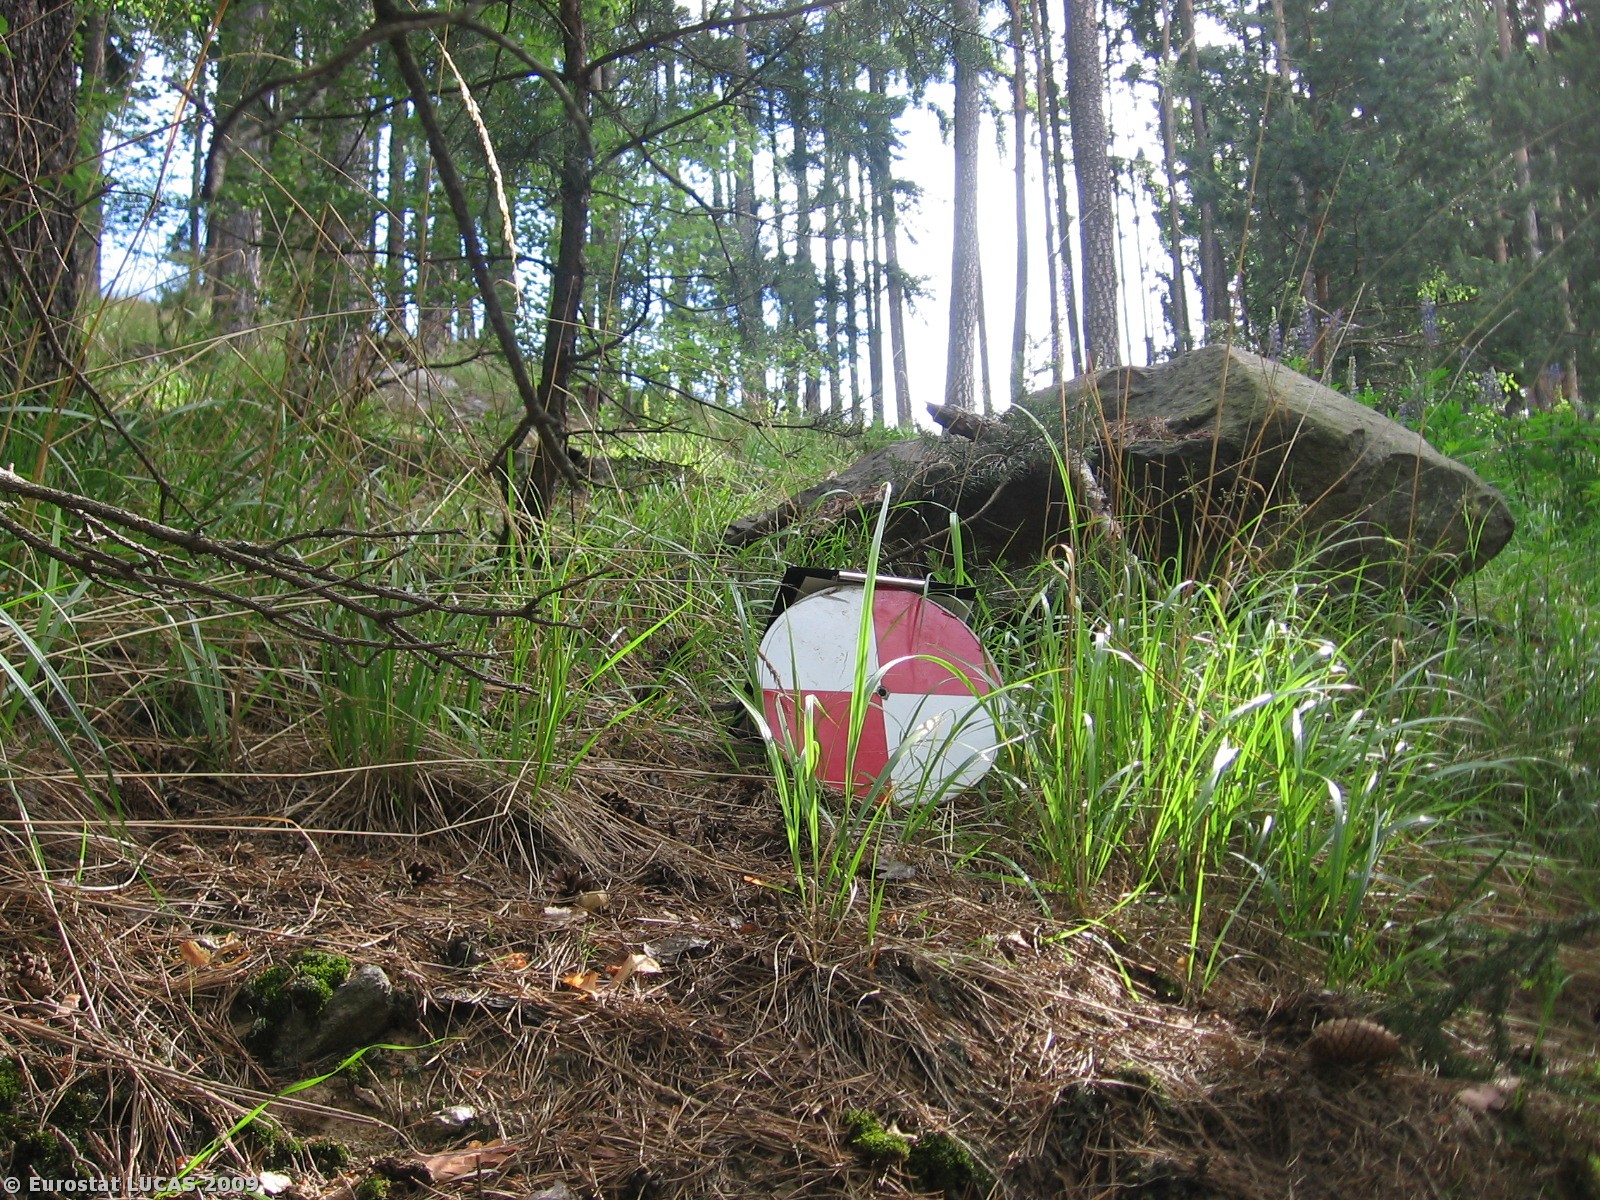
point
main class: Woodland
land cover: Coniferous woodland
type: hemiboreal forest and nemoral coniferous forest and mixed broadleaved-coniferous forest
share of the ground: > 75 %
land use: Forestry
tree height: > 5 m
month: June
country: CZ
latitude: 49.1289
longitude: 13.8513
